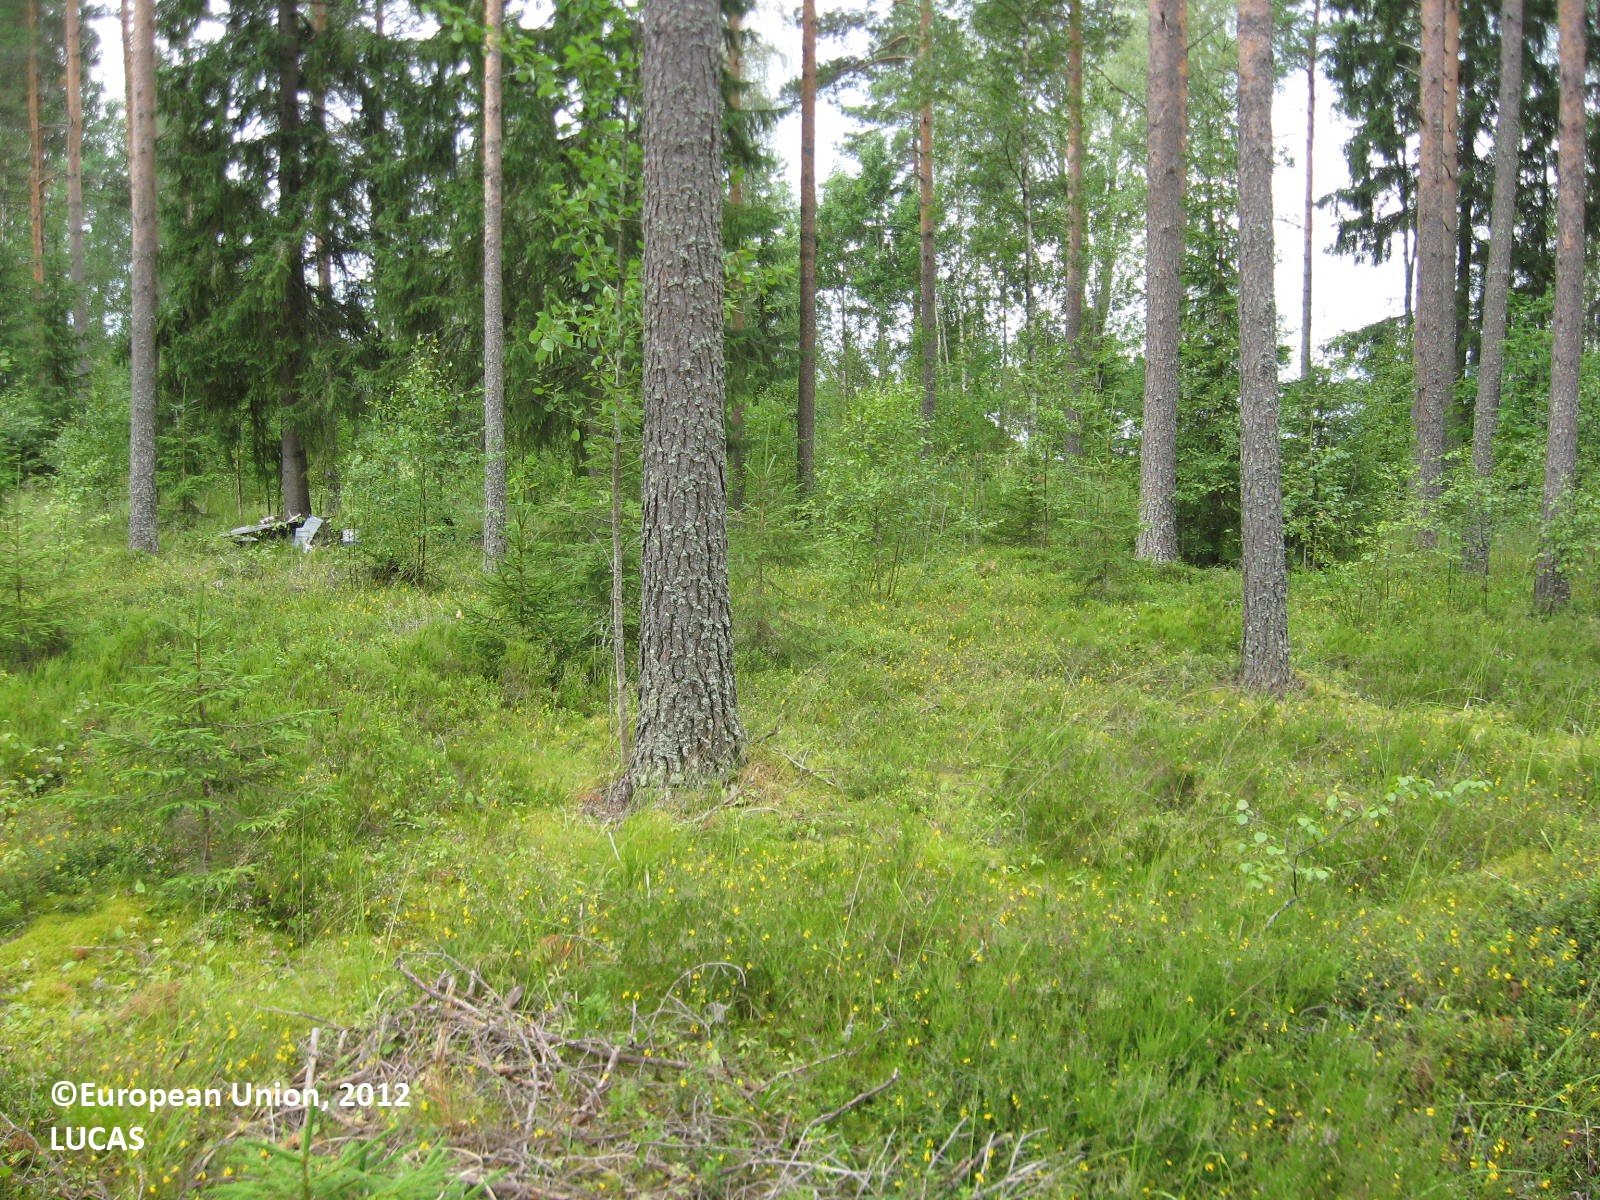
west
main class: Woodland
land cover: Pine dominated coniferous woodland
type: boreal forest
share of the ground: > 75 %
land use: Forestry
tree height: > 5 m
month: July
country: FI
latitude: 62.1444
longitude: 22.2761
